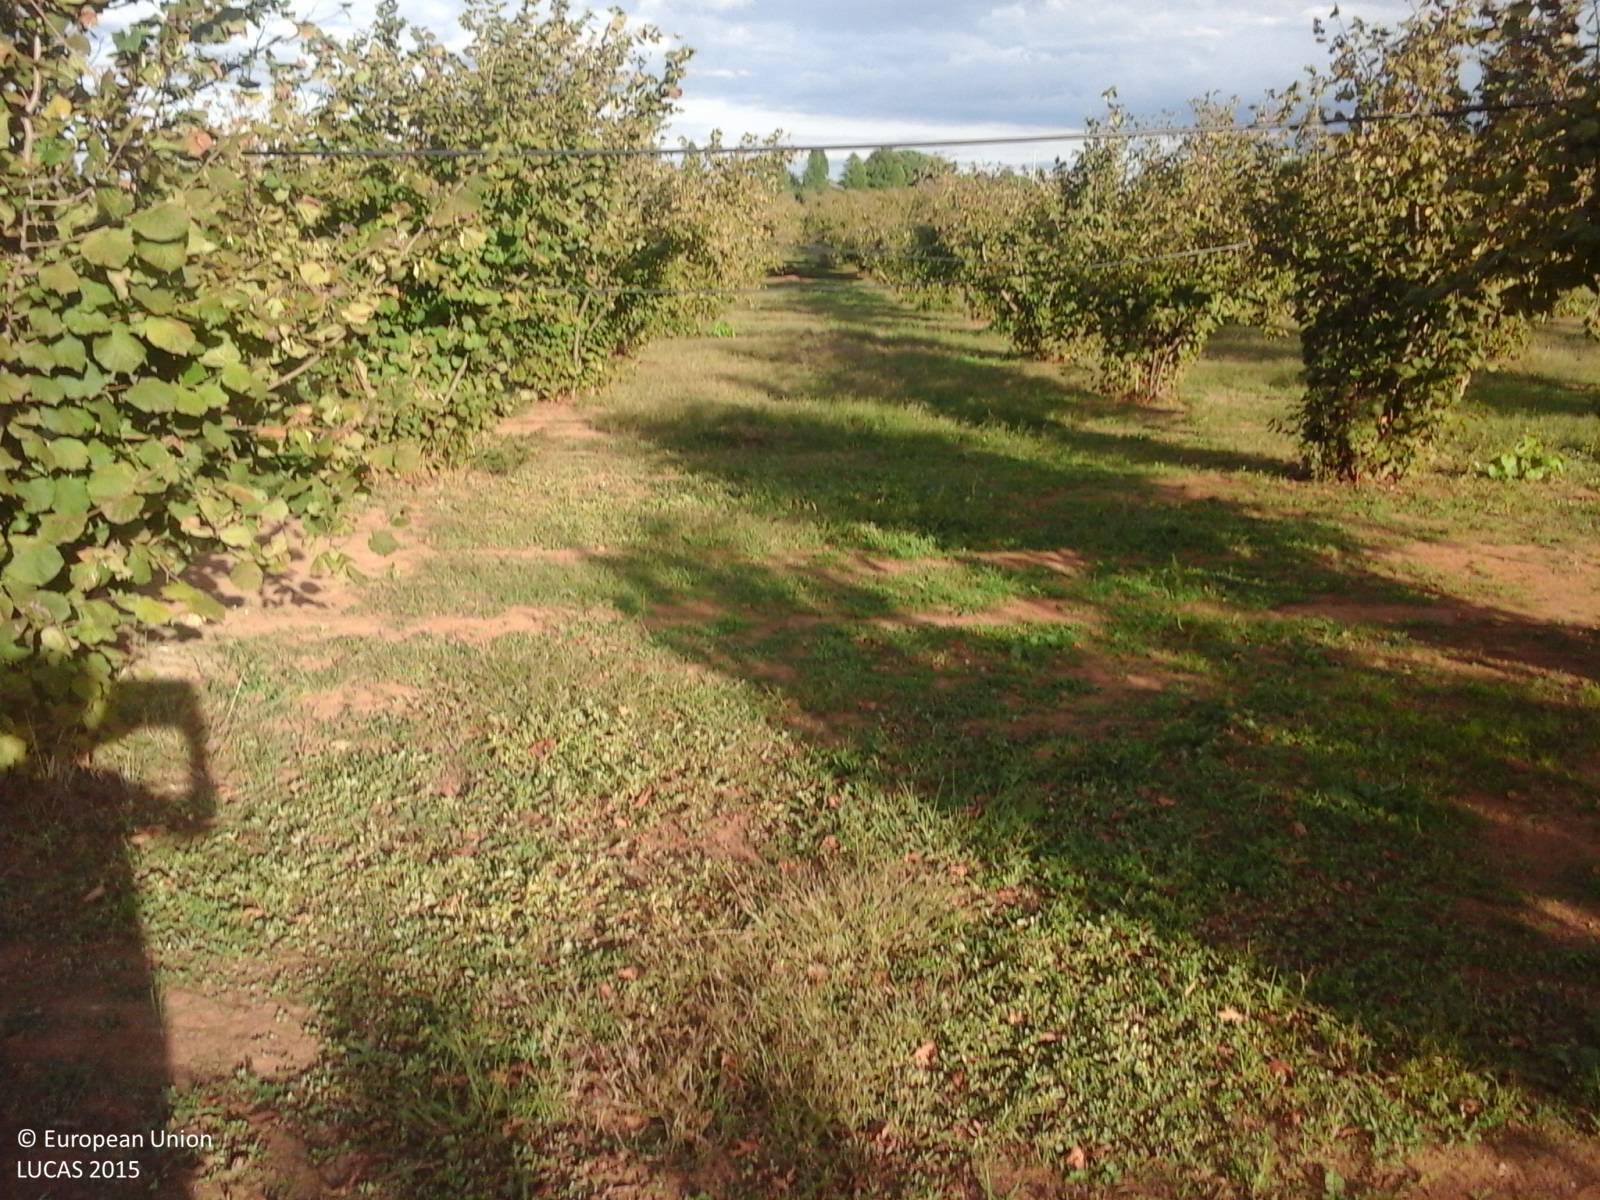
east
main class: Cropland
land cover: Nuts trees
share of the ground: > 75 %
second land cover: Spontaneously vegetated surfaces
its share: > 75 %
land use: Agriculture (excluding fallow land and kitchen gardens)
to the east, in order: Nuts trees; Spontaneously vegetated surfaces; Tracks; Grass margins; Fences; Grassland without tree/shrub cover
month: September
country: IT
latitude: 42.4102
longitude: 12.3373
